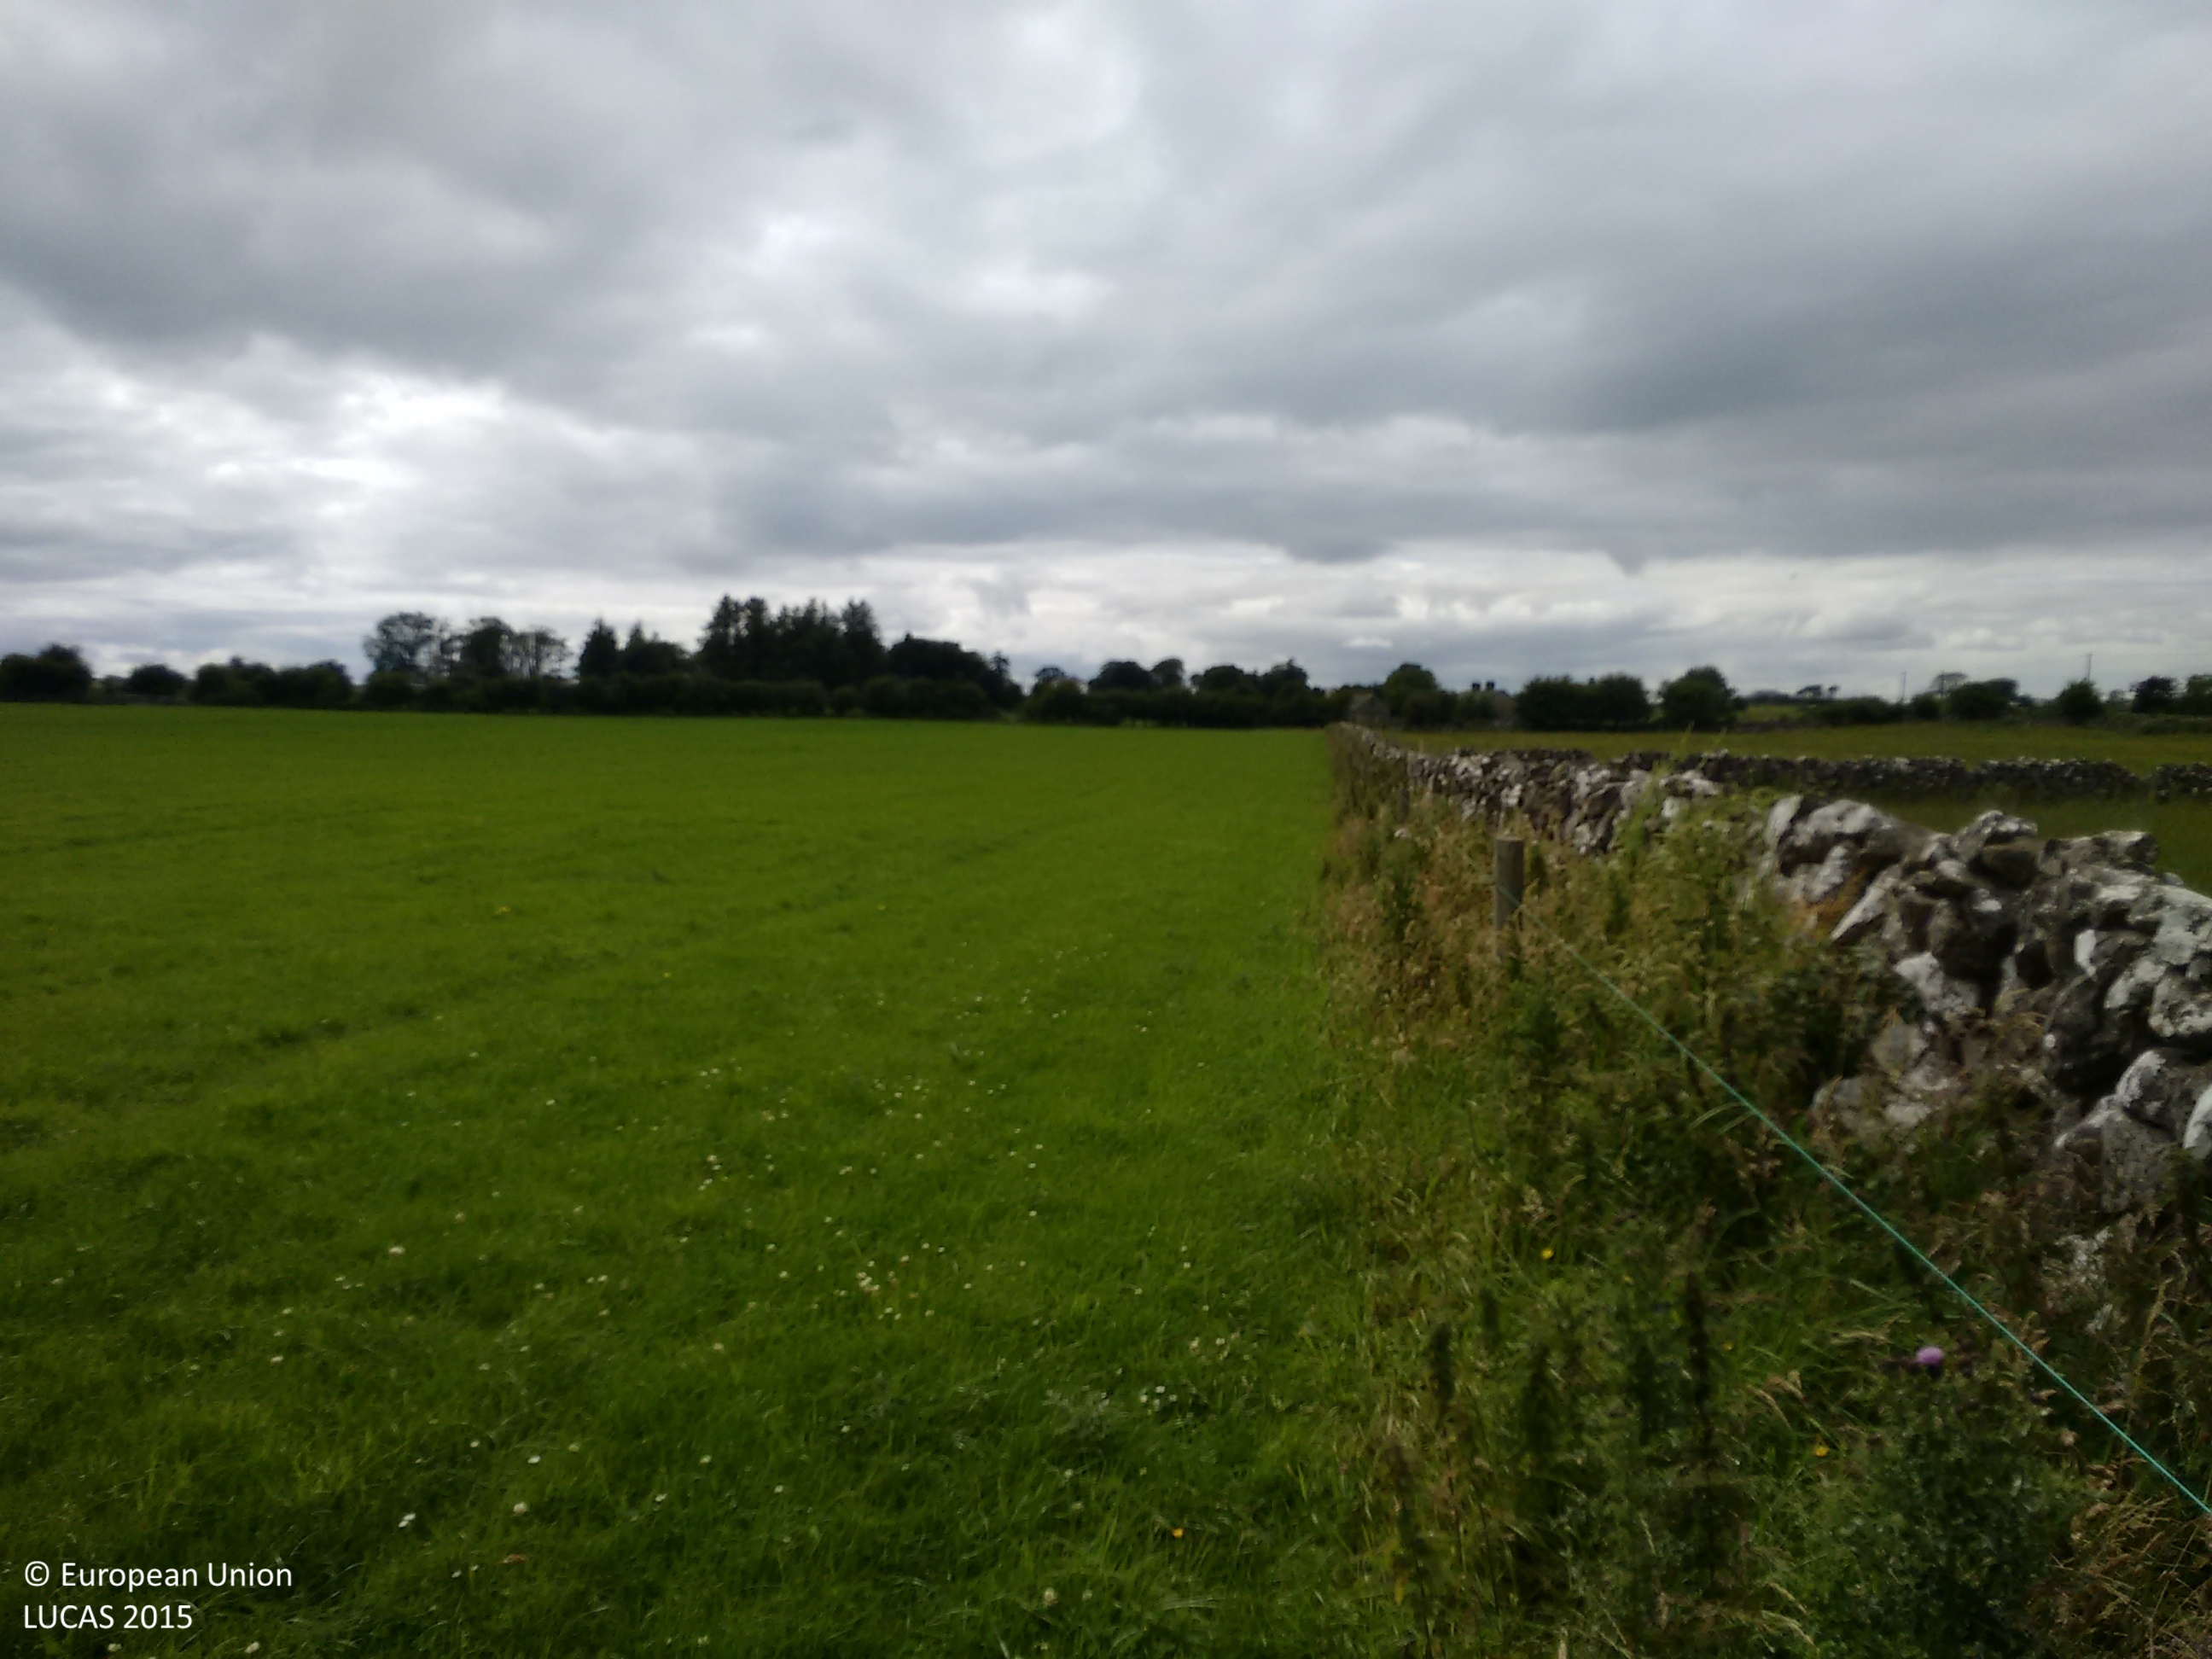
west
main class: Grassland
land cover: Grassland without tree/shrub cover
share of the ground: > 75 %
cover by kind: herbaceous plants 100 %
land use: Agriculture (excluding fallow land and kitchen gardens)
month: July
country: IE
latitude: 53.6413
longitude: -9.0771
